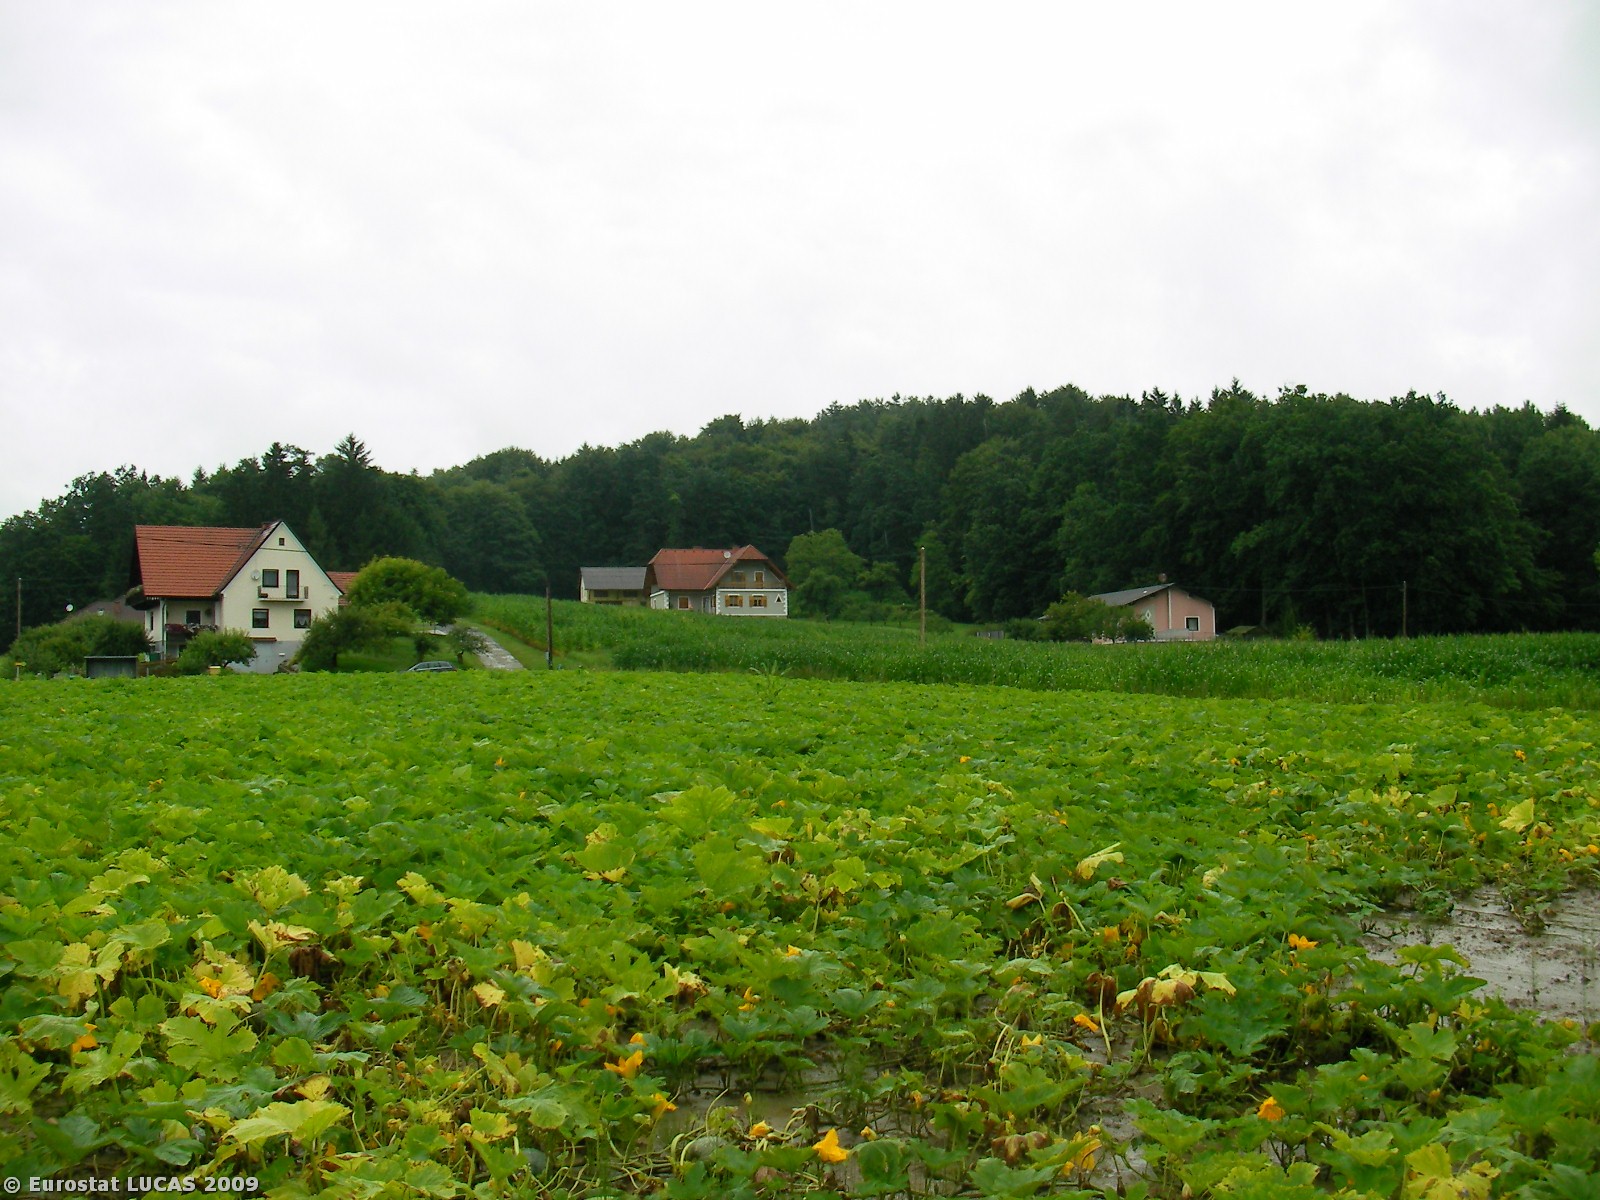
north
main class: Cropland
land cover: Other fibre and oleaginous crops
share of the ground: > 75 %
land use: Agriculture (excluding fallow land and kitchen gardens)
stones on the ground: < 10 %
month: July
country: AT
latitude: 46.9386
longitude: 15.7144
